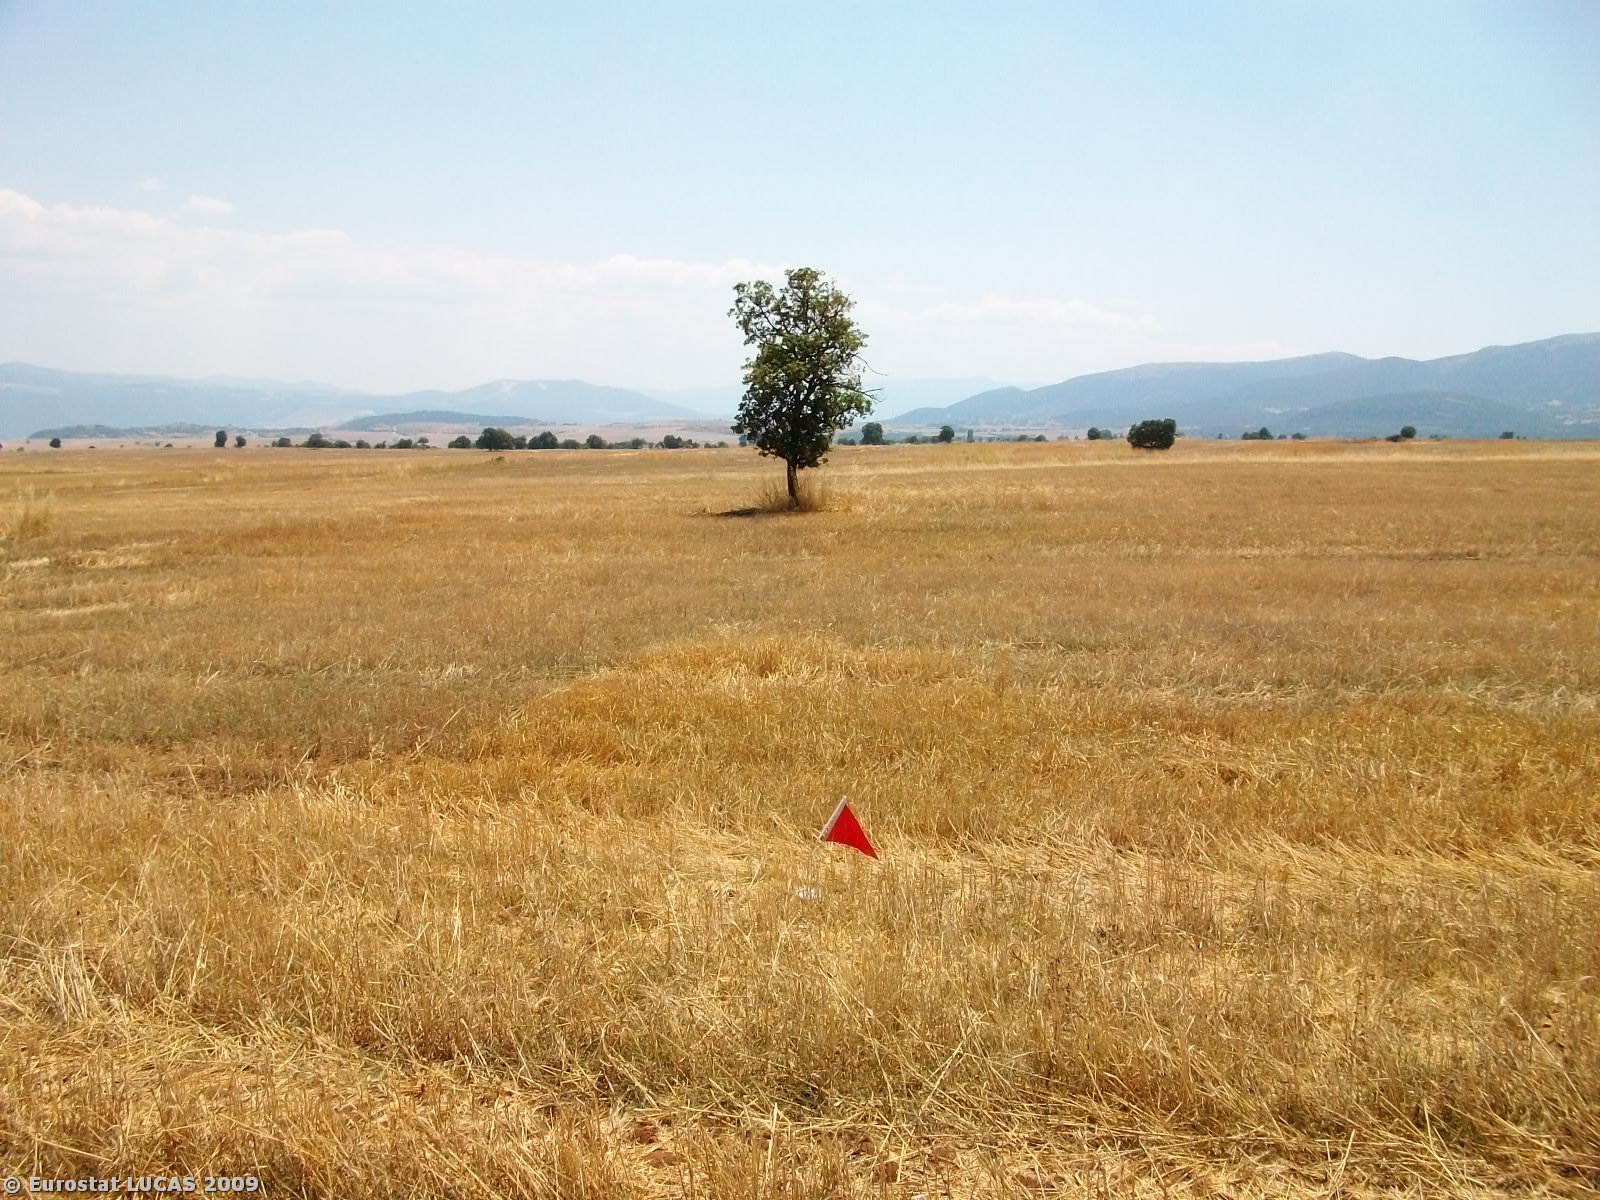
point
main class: Cropland
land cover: Durum wheat
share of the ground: < 10 %
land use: Agriculture (excluding fallow land and kitchen gardens)
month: July
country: GR
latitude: 40.2102
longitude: 21.7991
